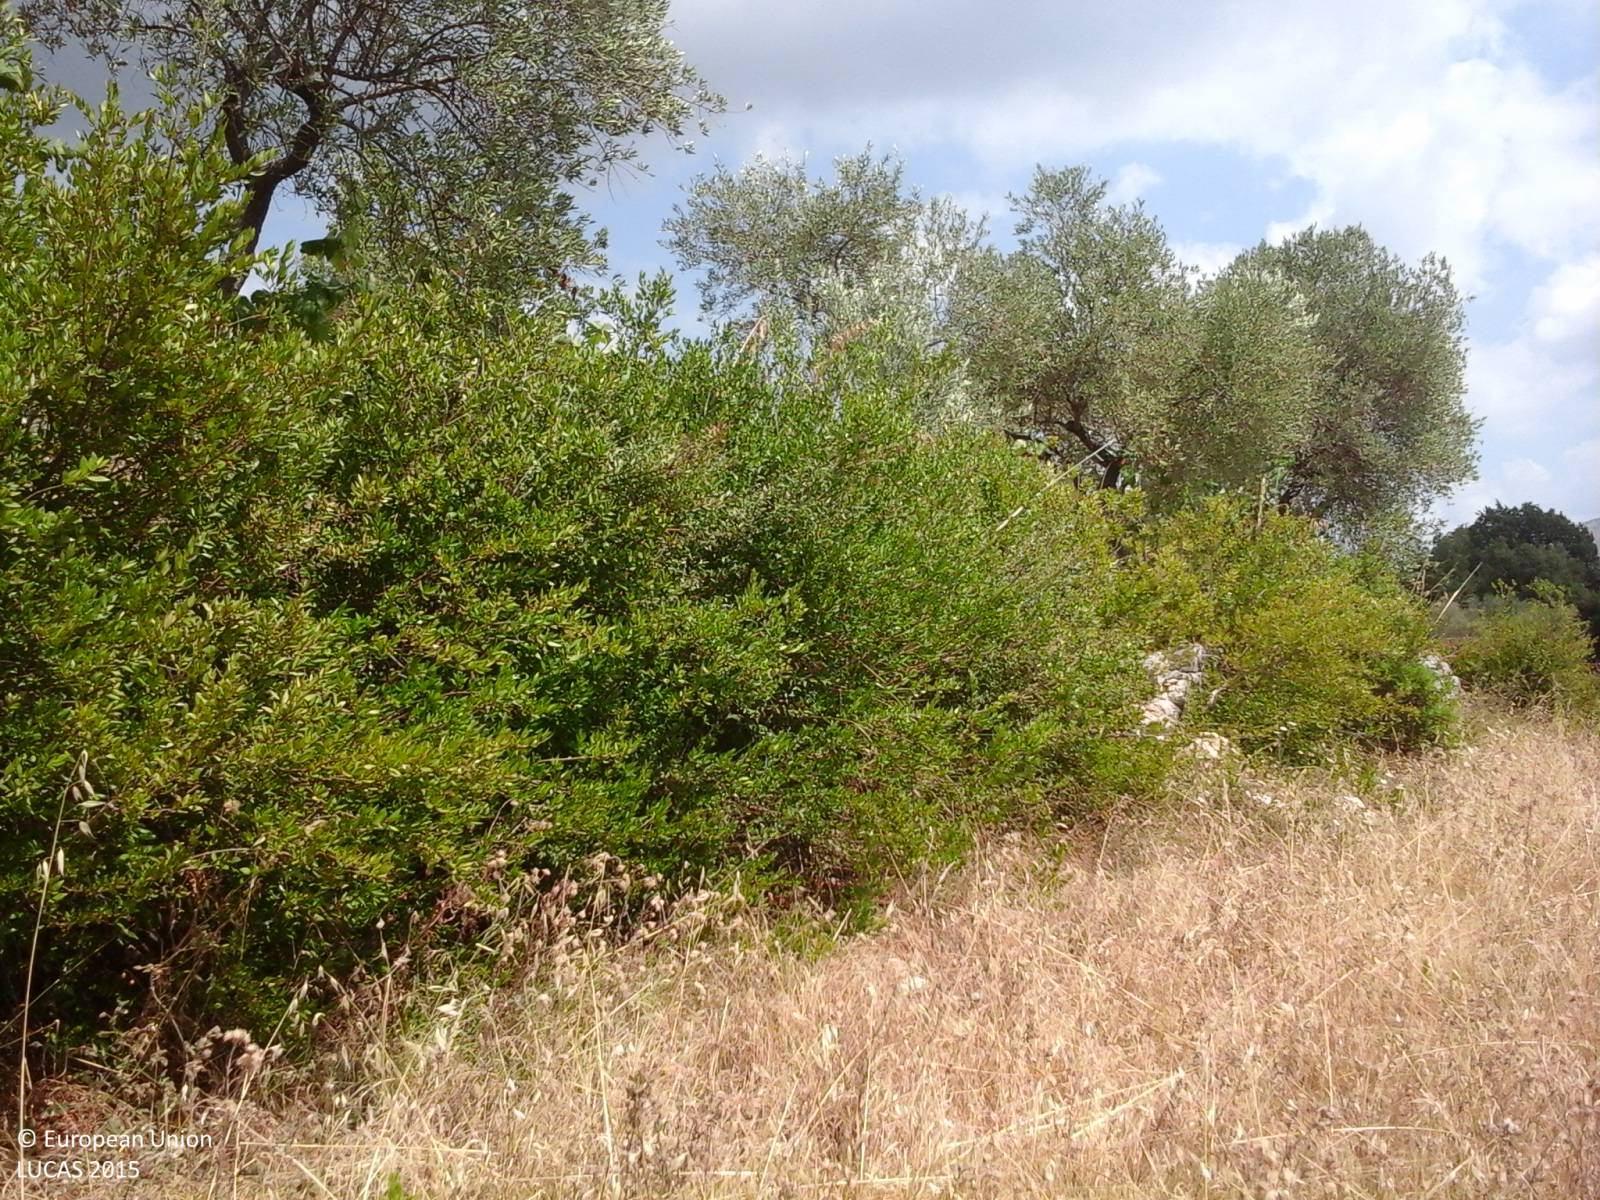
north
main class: Grassland
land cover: Spontaneously vegetated surfaces
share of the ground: > 75 %
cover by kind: herbaceous plants 100 %
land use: Fallow land
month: July
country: IT
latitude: 41.3374
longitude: 13.7256
